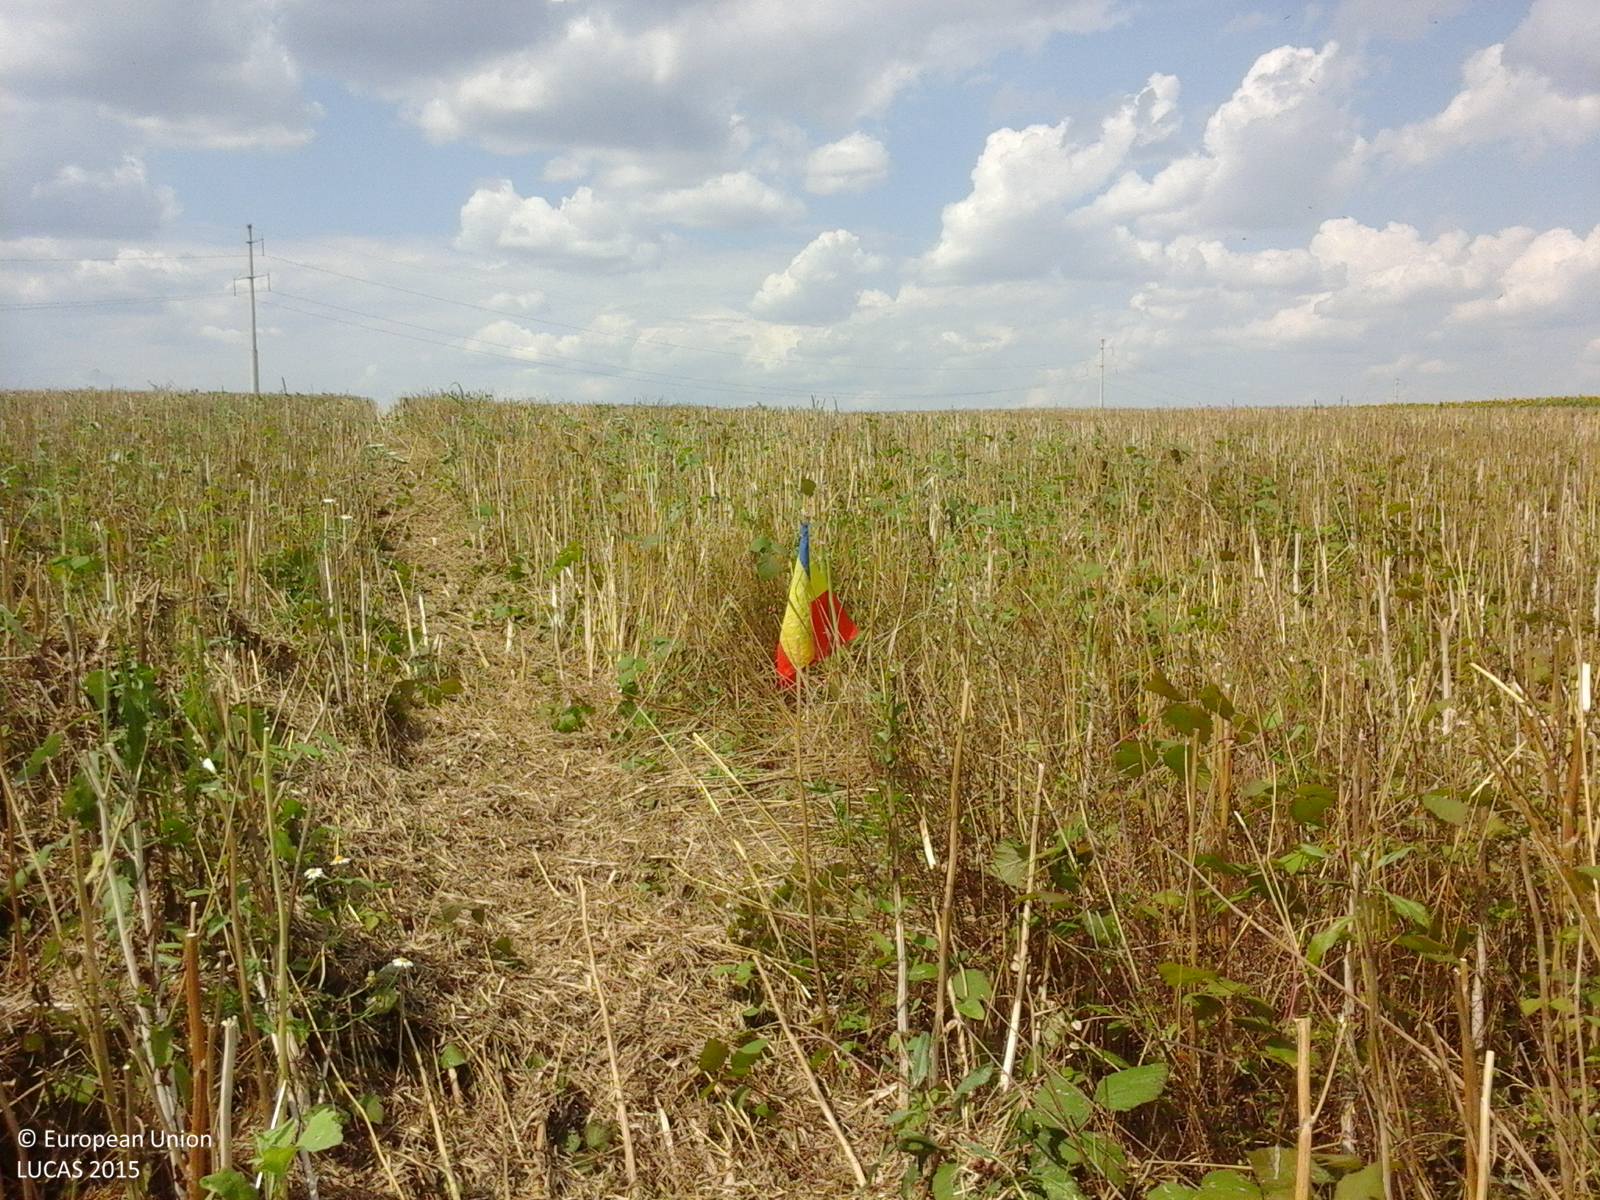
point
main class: Cropland
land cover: Rape and turnip rape
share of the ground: < 10 %
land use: Agriculture (excluding fallow land and kitchen gardens)
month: June
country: RO
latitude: 44.1186
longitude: 26.2884
